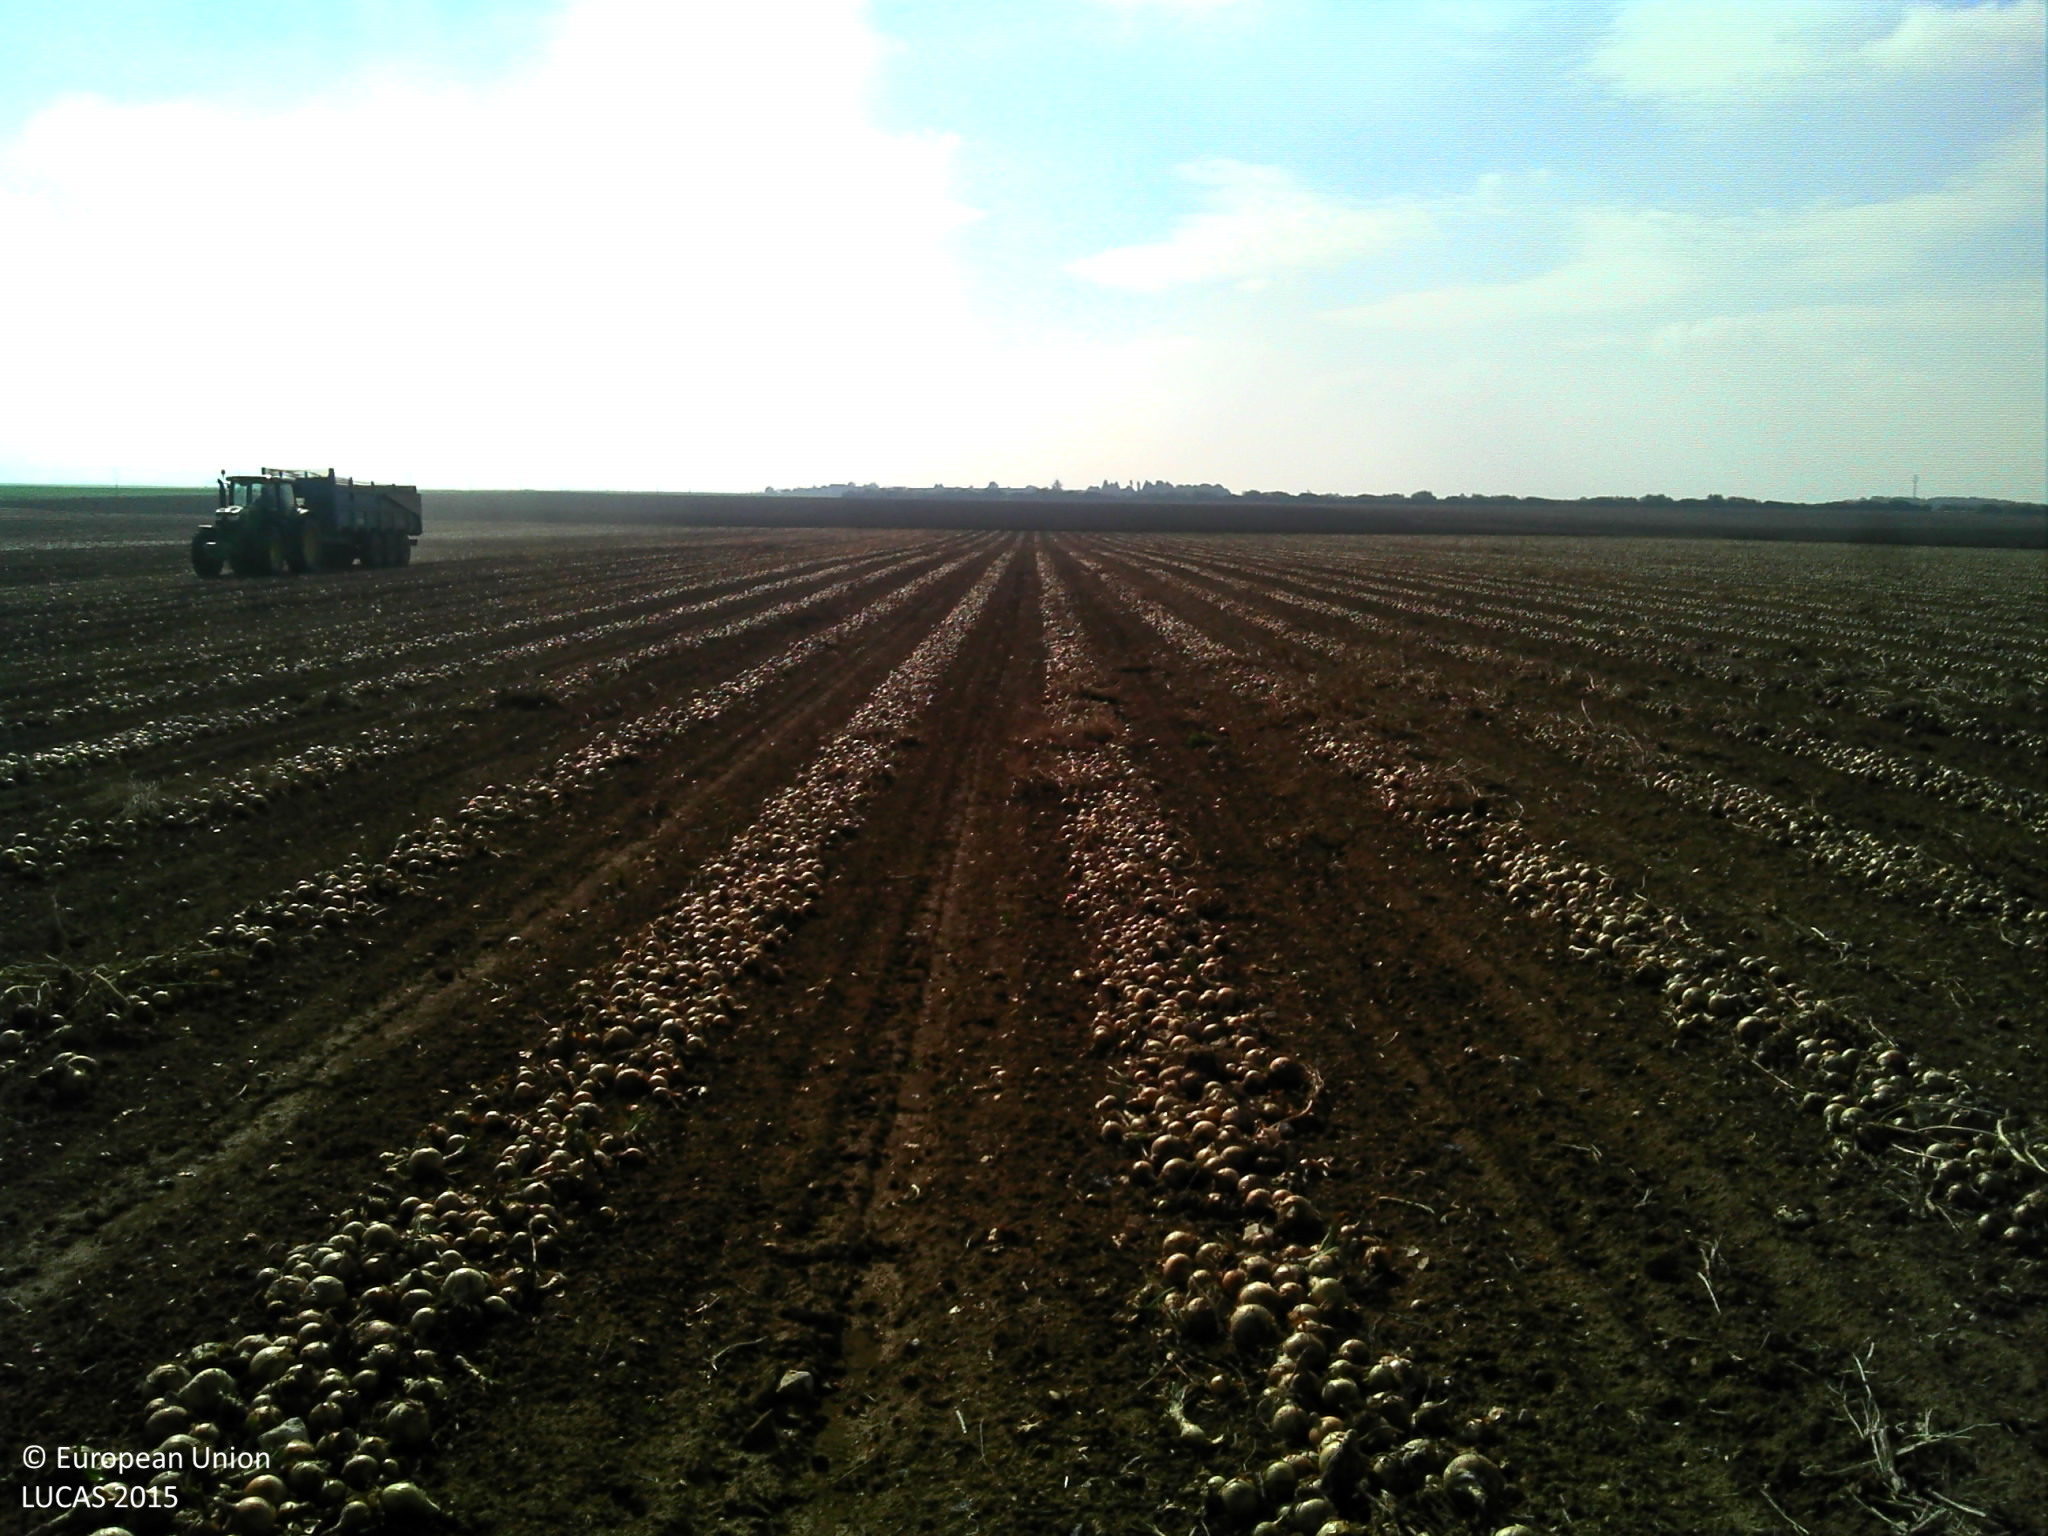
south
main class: Cropland
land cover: Other root crops
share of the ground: 25 - 50 %
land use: Agriculture (excluding fallow land and kitchen gardens)
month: October
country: FR
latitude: 47.8123
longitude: 1.3706
